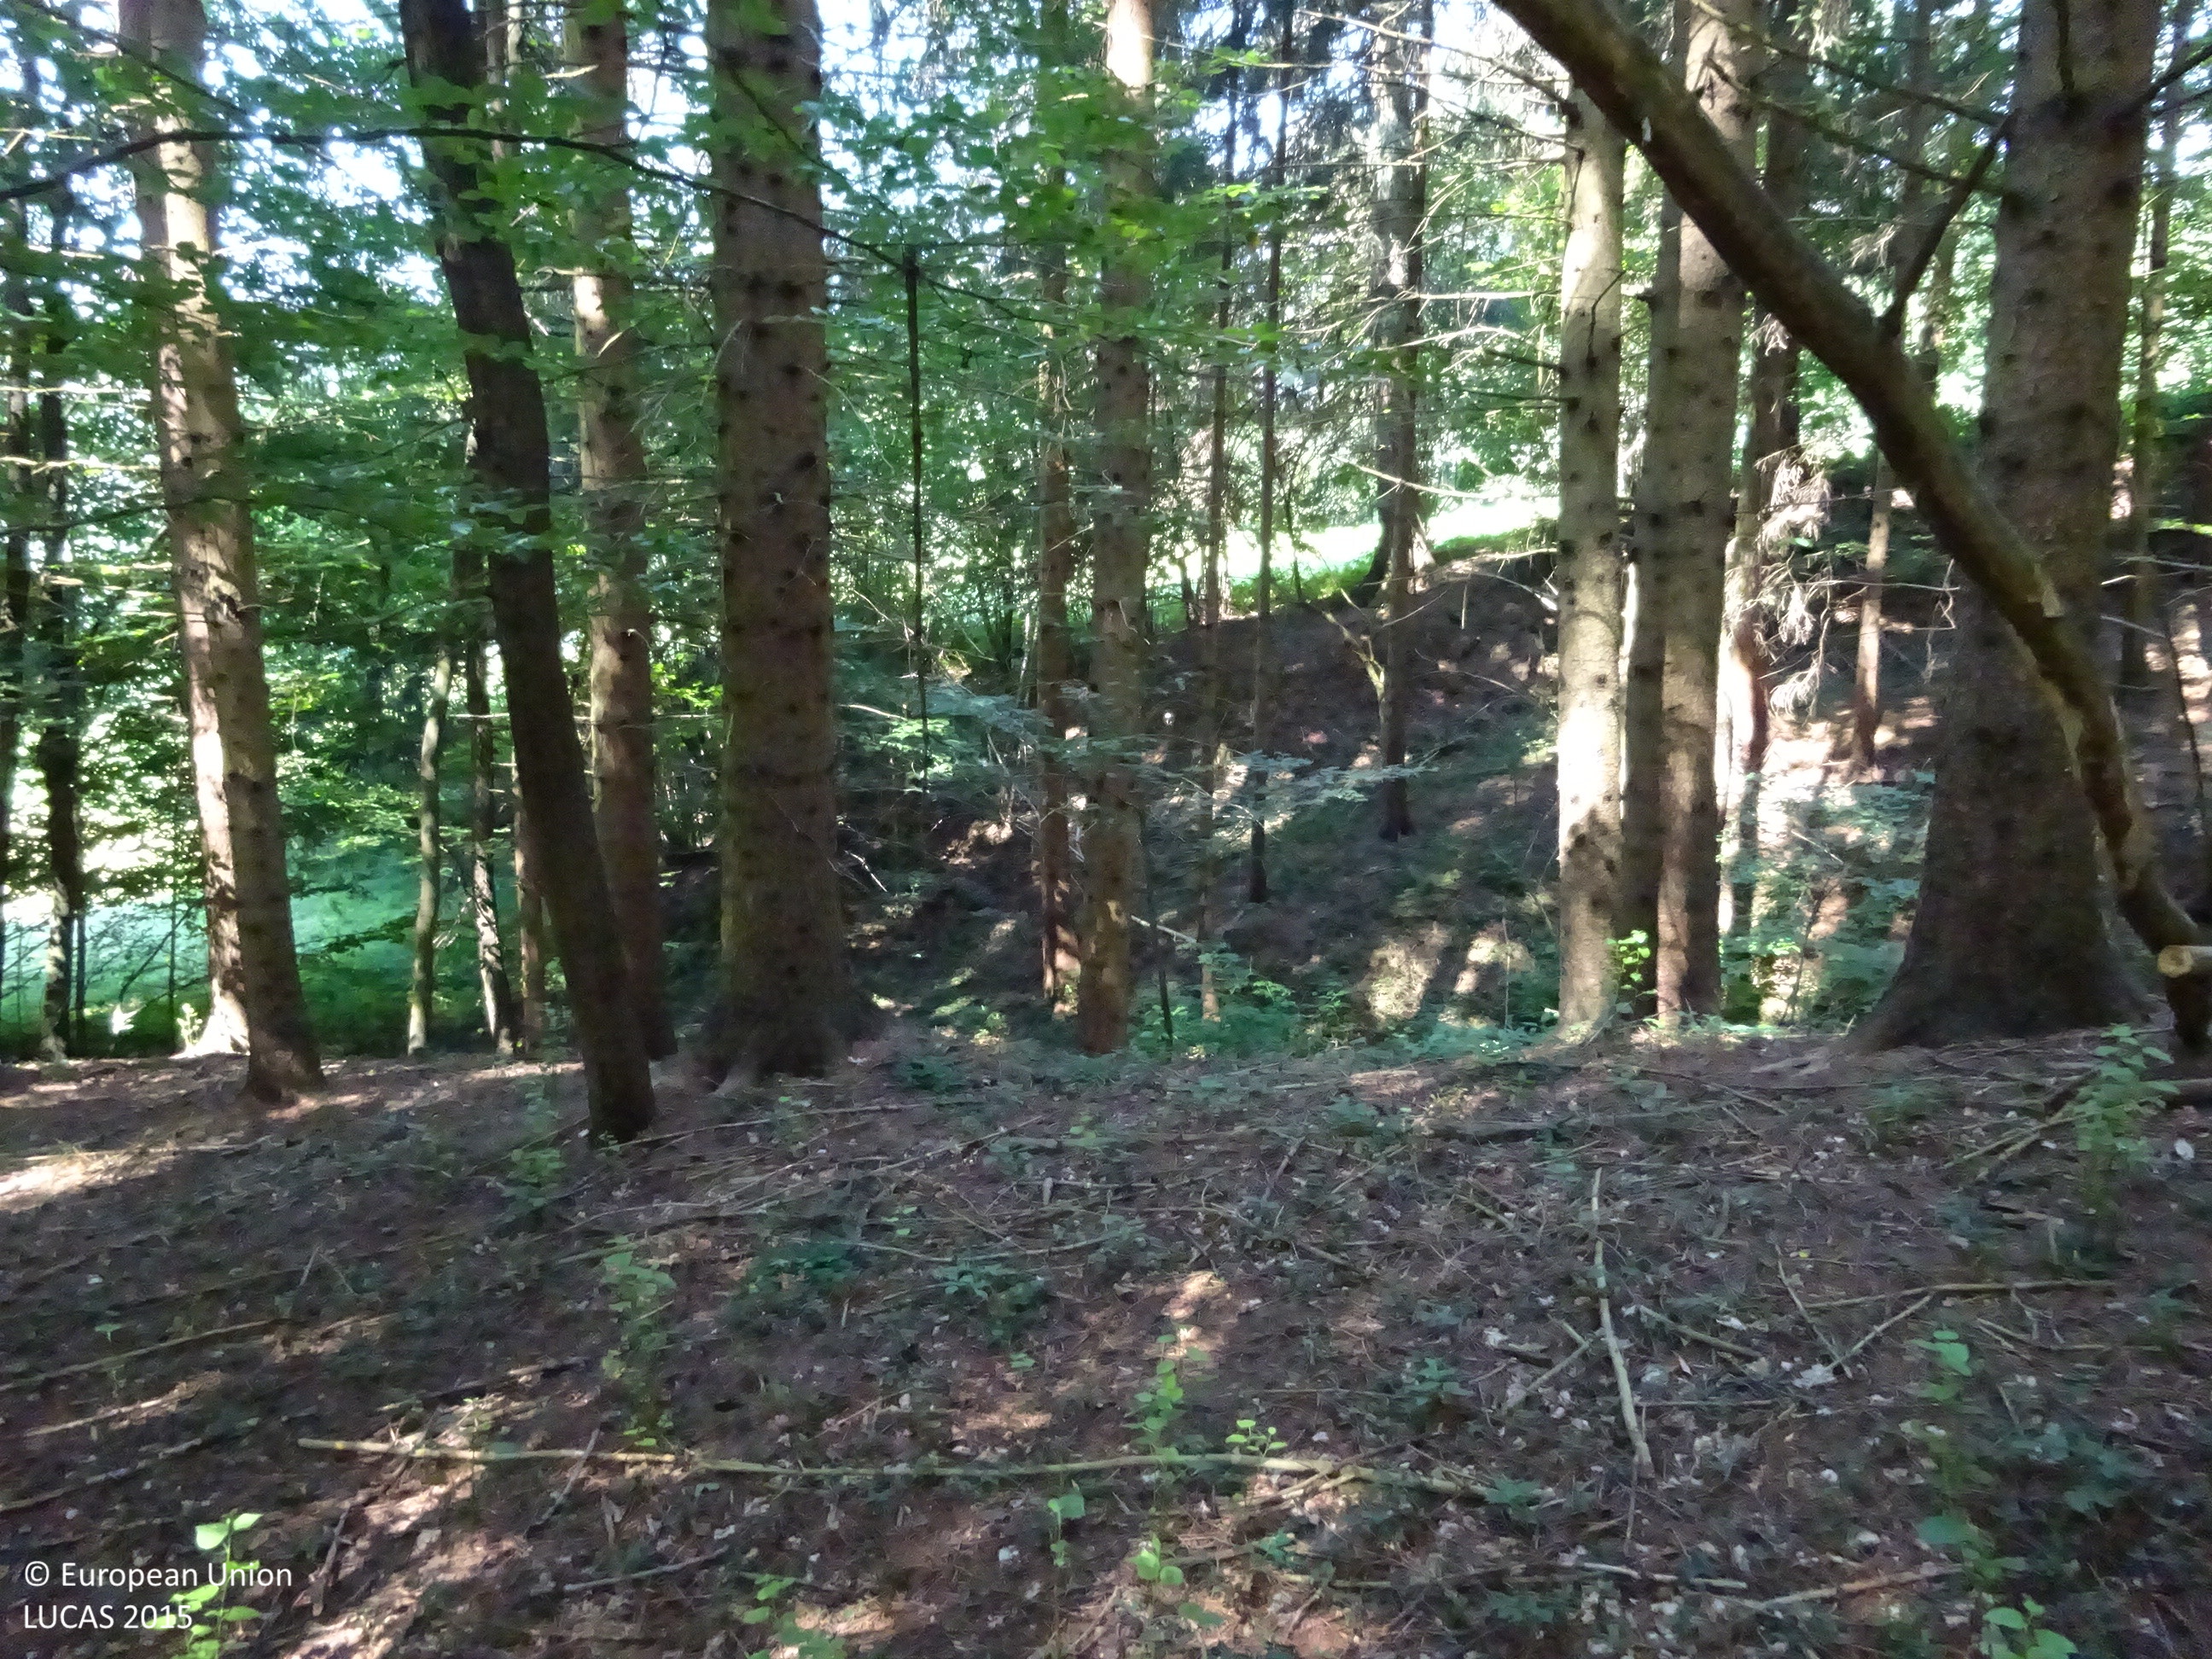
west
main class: Woodland
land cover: Spruce dominated coniferous woodland
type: alpine coniferous forest
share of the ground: > 75 %
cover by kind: coniferous forest trees 95 %, broadleaved forest trees 5 %
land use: Forestry
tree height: > 5 m
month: August
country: AT
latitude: 47.4596
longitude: 16.0910
